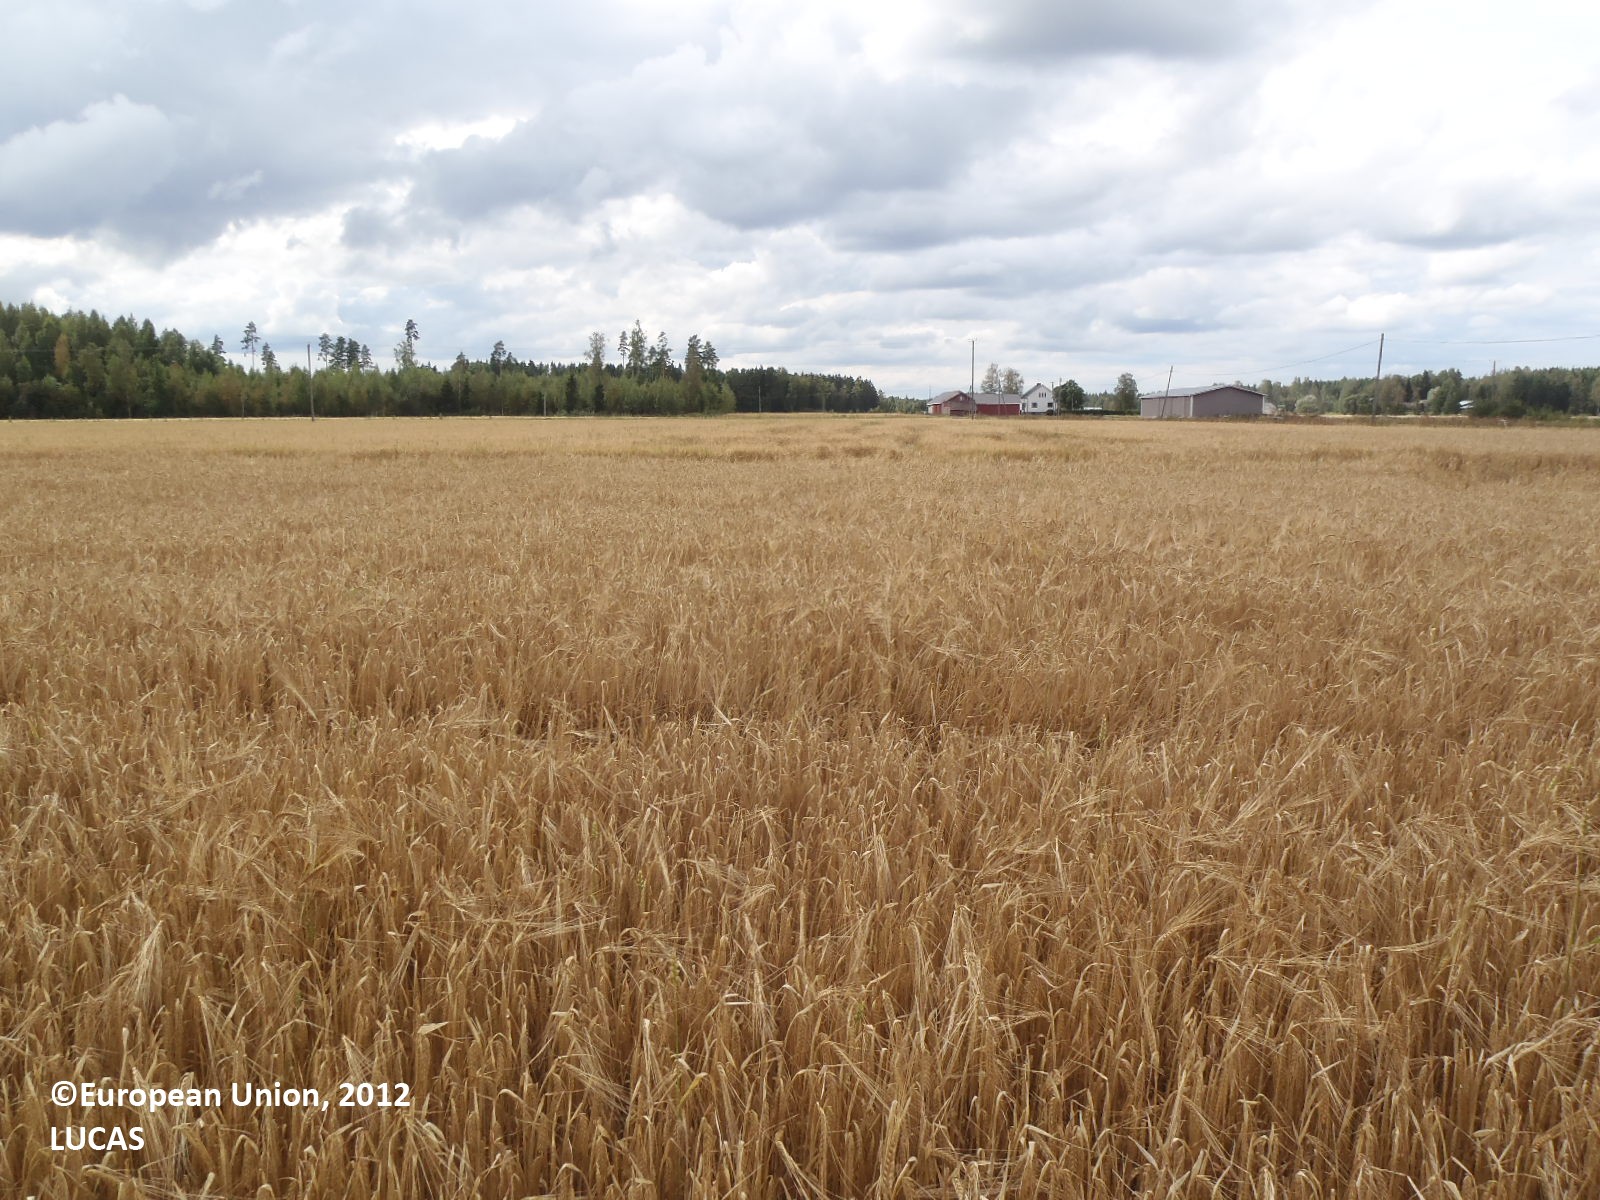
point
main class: Cropland
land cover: Barley
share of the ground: > 75 %
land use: Agriculture (excluding fallow land and kitchen gardens)
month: August
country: FI
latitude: 60.6844
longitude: 22.4641
